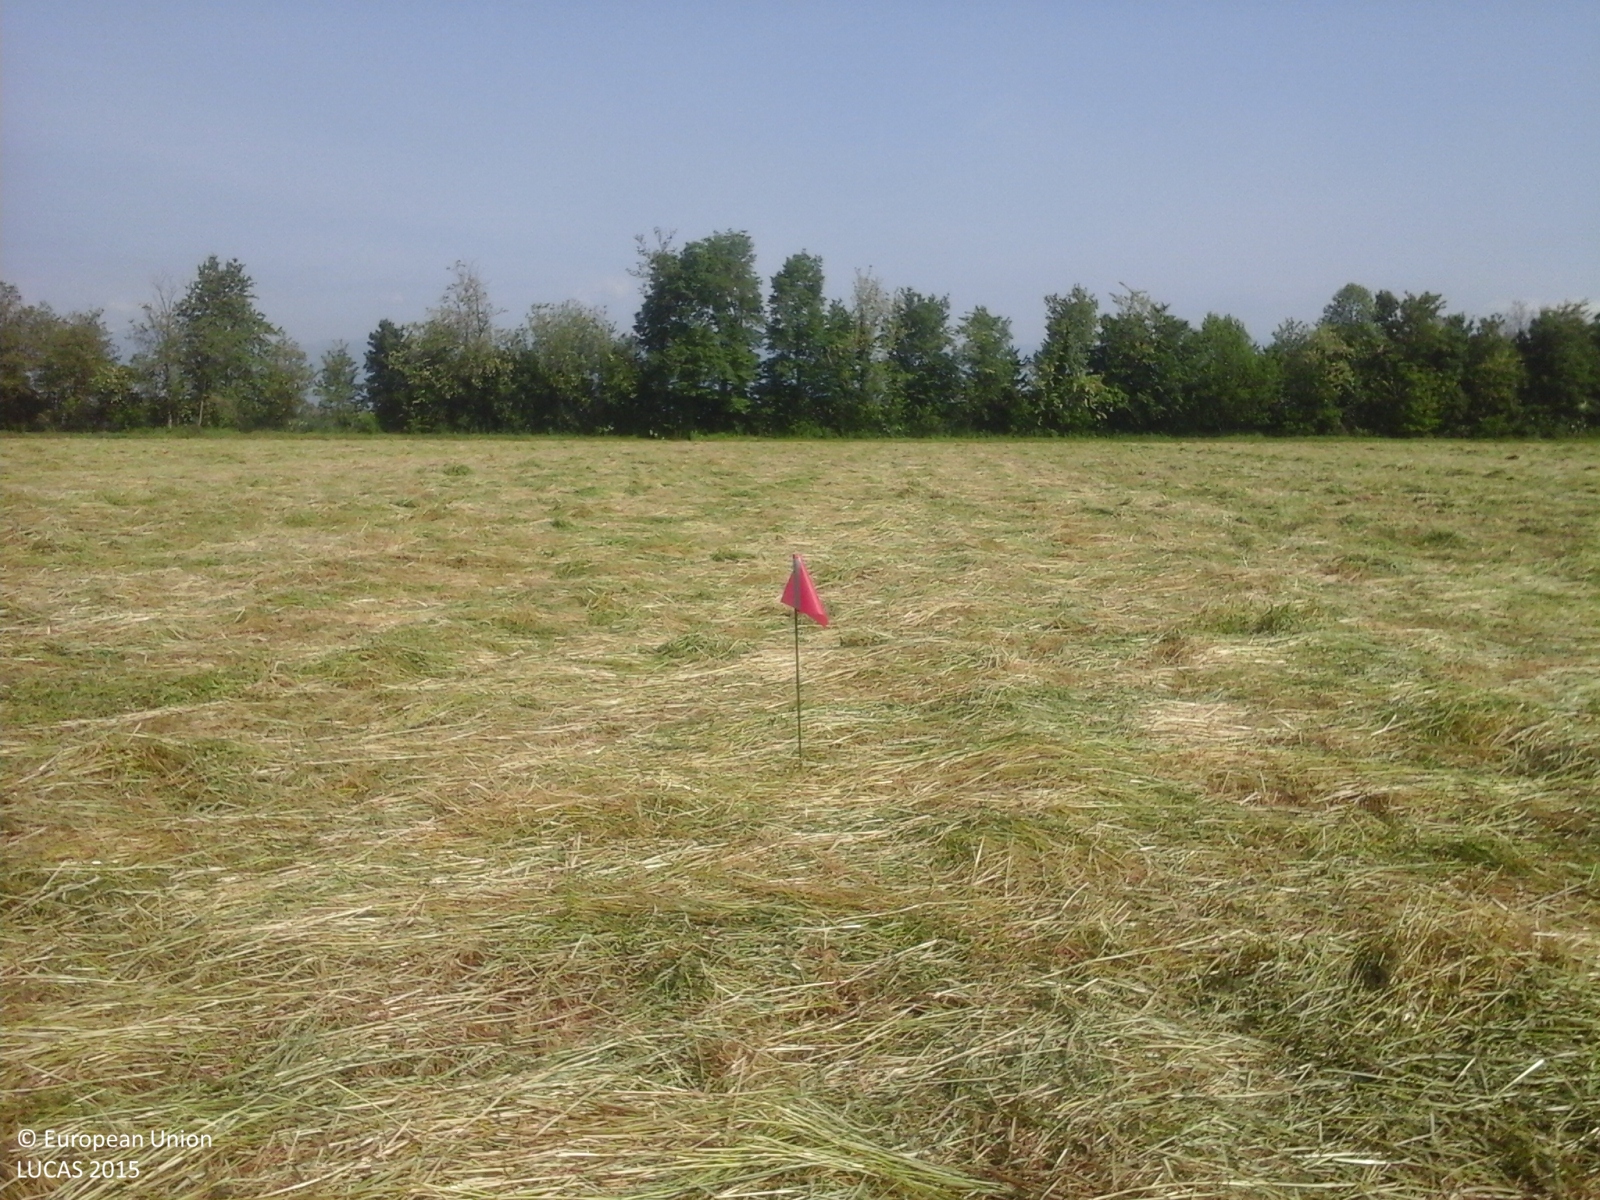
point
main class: Cropland
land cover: Temporary grasslands
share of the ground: > 75 %
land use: Agriculture (excluding fallow land and kitchen gardens)
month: May
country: IT
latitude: 45.6705
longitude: 11.7302
